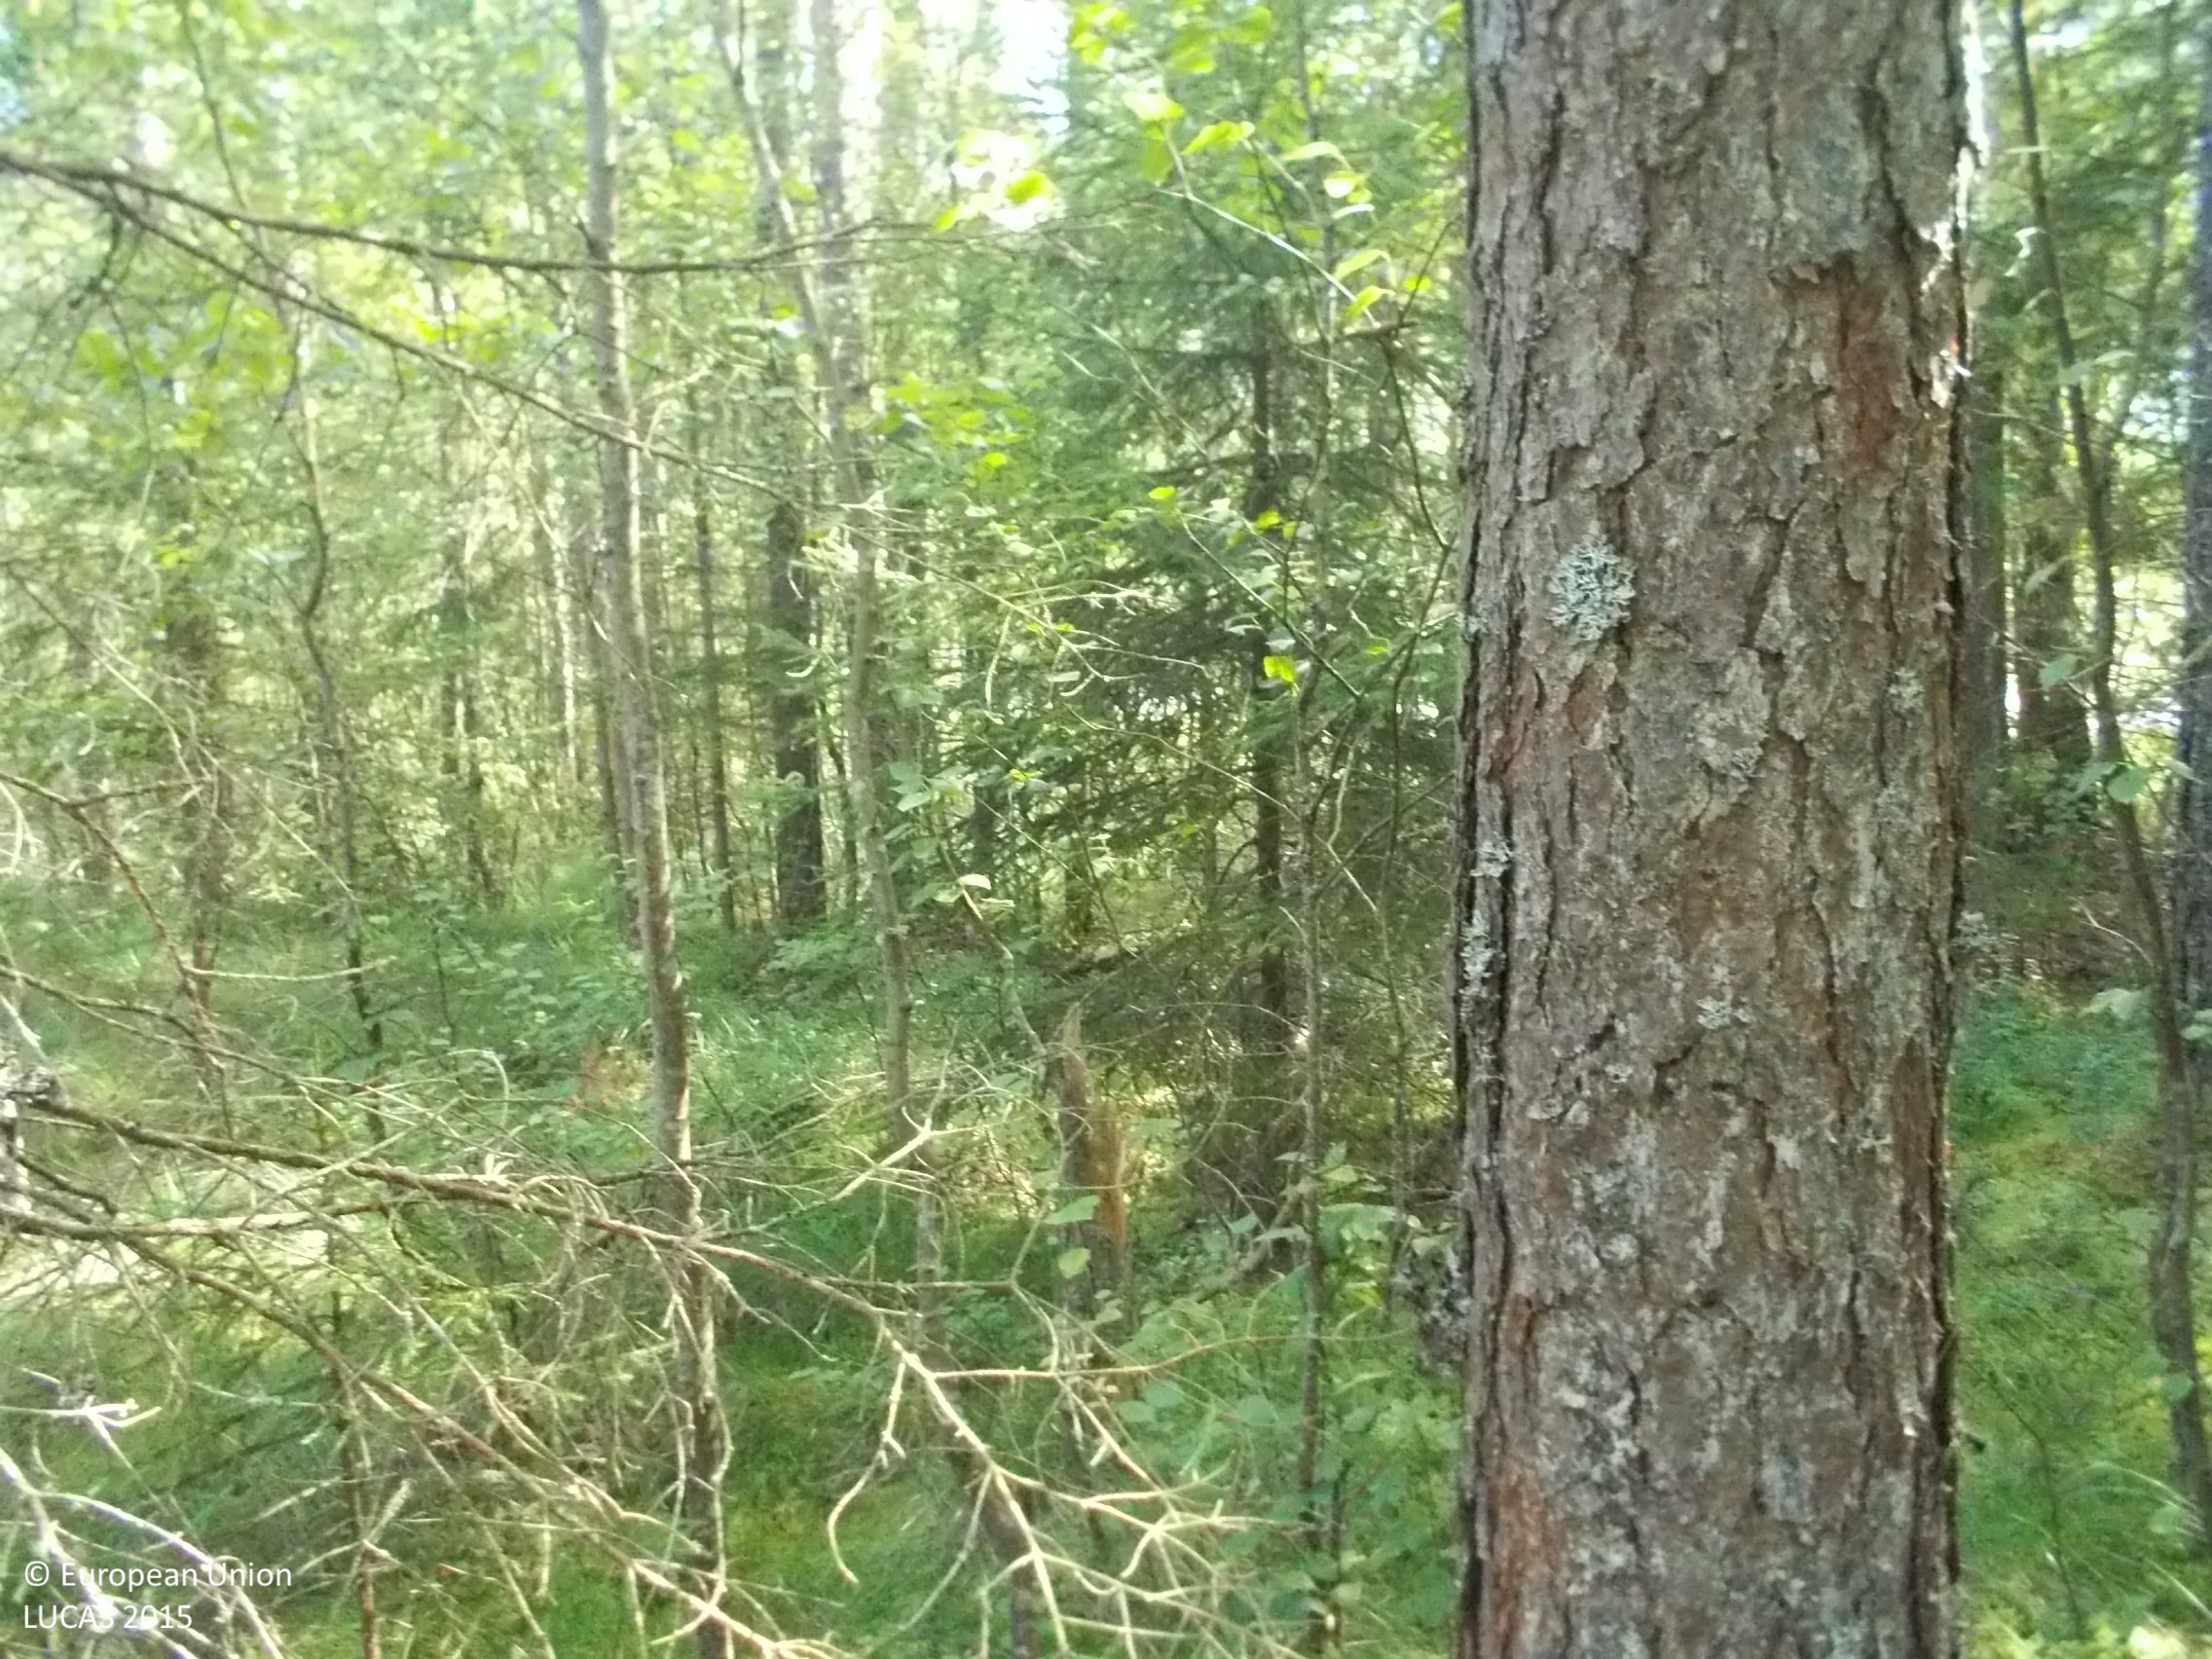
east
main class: Woodland
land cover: Other mixed woodland
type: boreal forest
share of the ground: > 75 %
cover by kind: coniferous forest trees 60 %, broadleaved forest trees 25 %, herbaceous plants 10 %, lichens and mosses 5 %
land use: Forestry
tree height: > 5 m
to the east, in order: Other mixed woodland; Ditches and canals; Grass margins; Paved roads, cycling and walking lanes; Grass margins; Pine dominated mixed woodland; Tracks; Spruce dominated mixed woodland; Pine dominated mixed woodland; Inland fresh water bodies
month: August
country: SE
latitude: 57.6228
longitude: 13.2270
